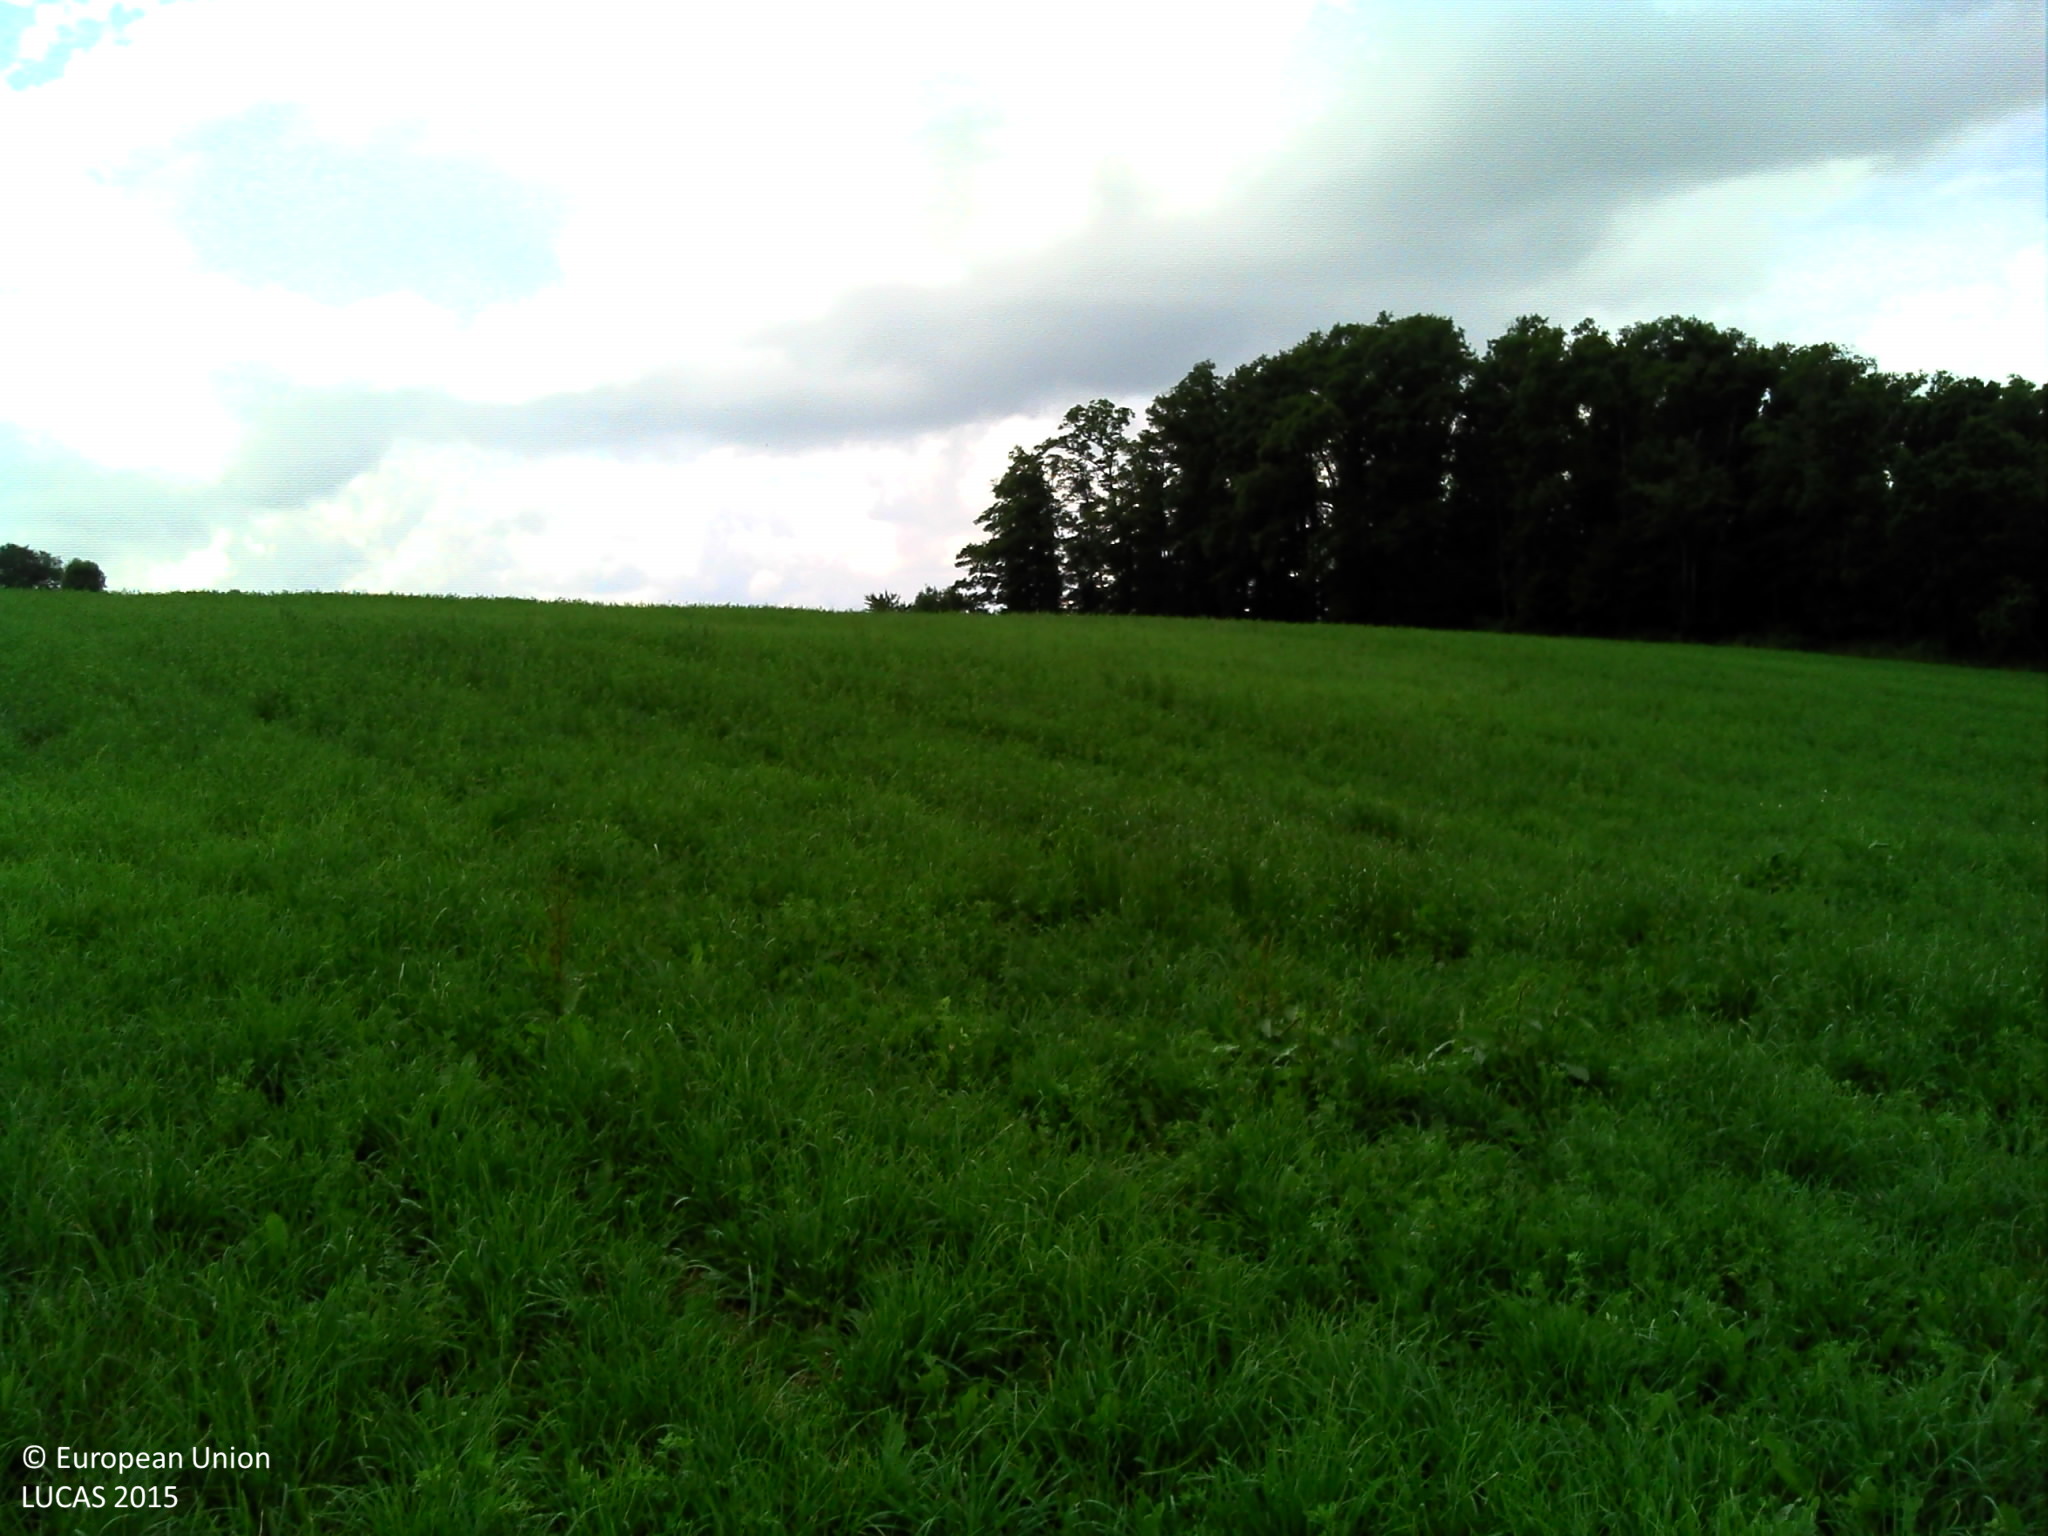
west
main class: Cropland
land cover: Temporary grasslands
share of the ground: > 75 %
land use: Agriculture (excluding fallow land and kitchen gardens)
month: June
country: FR
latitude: 44.3013
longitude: 2.5706
